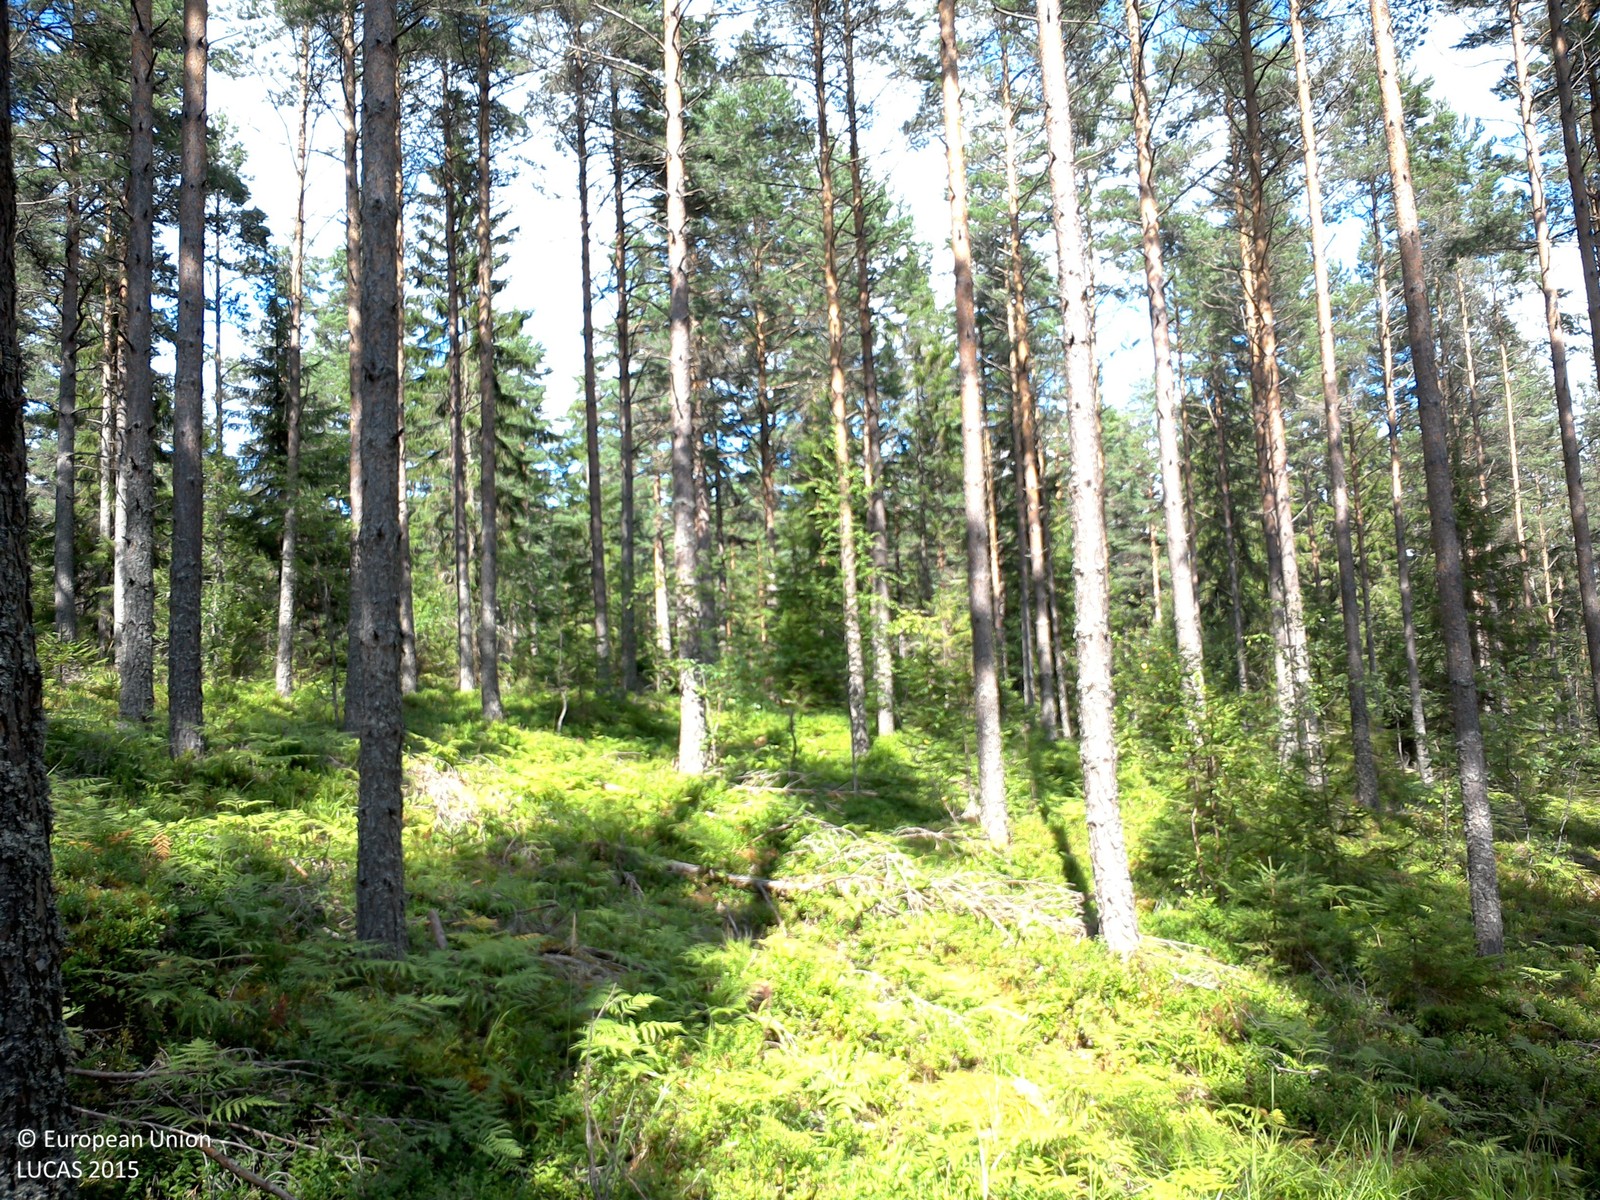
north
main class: Woodland
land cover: Pine dominated coniferous woodland
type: boreal forest
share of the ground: 25 - 50 %
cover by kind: herbaceous plants 65 %, coniferous forest trees 25 %, lichens and mosses 10 %
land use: Forestry
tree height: > 5 m
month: August
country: SE
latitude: 58.1645
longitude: 15.4171
